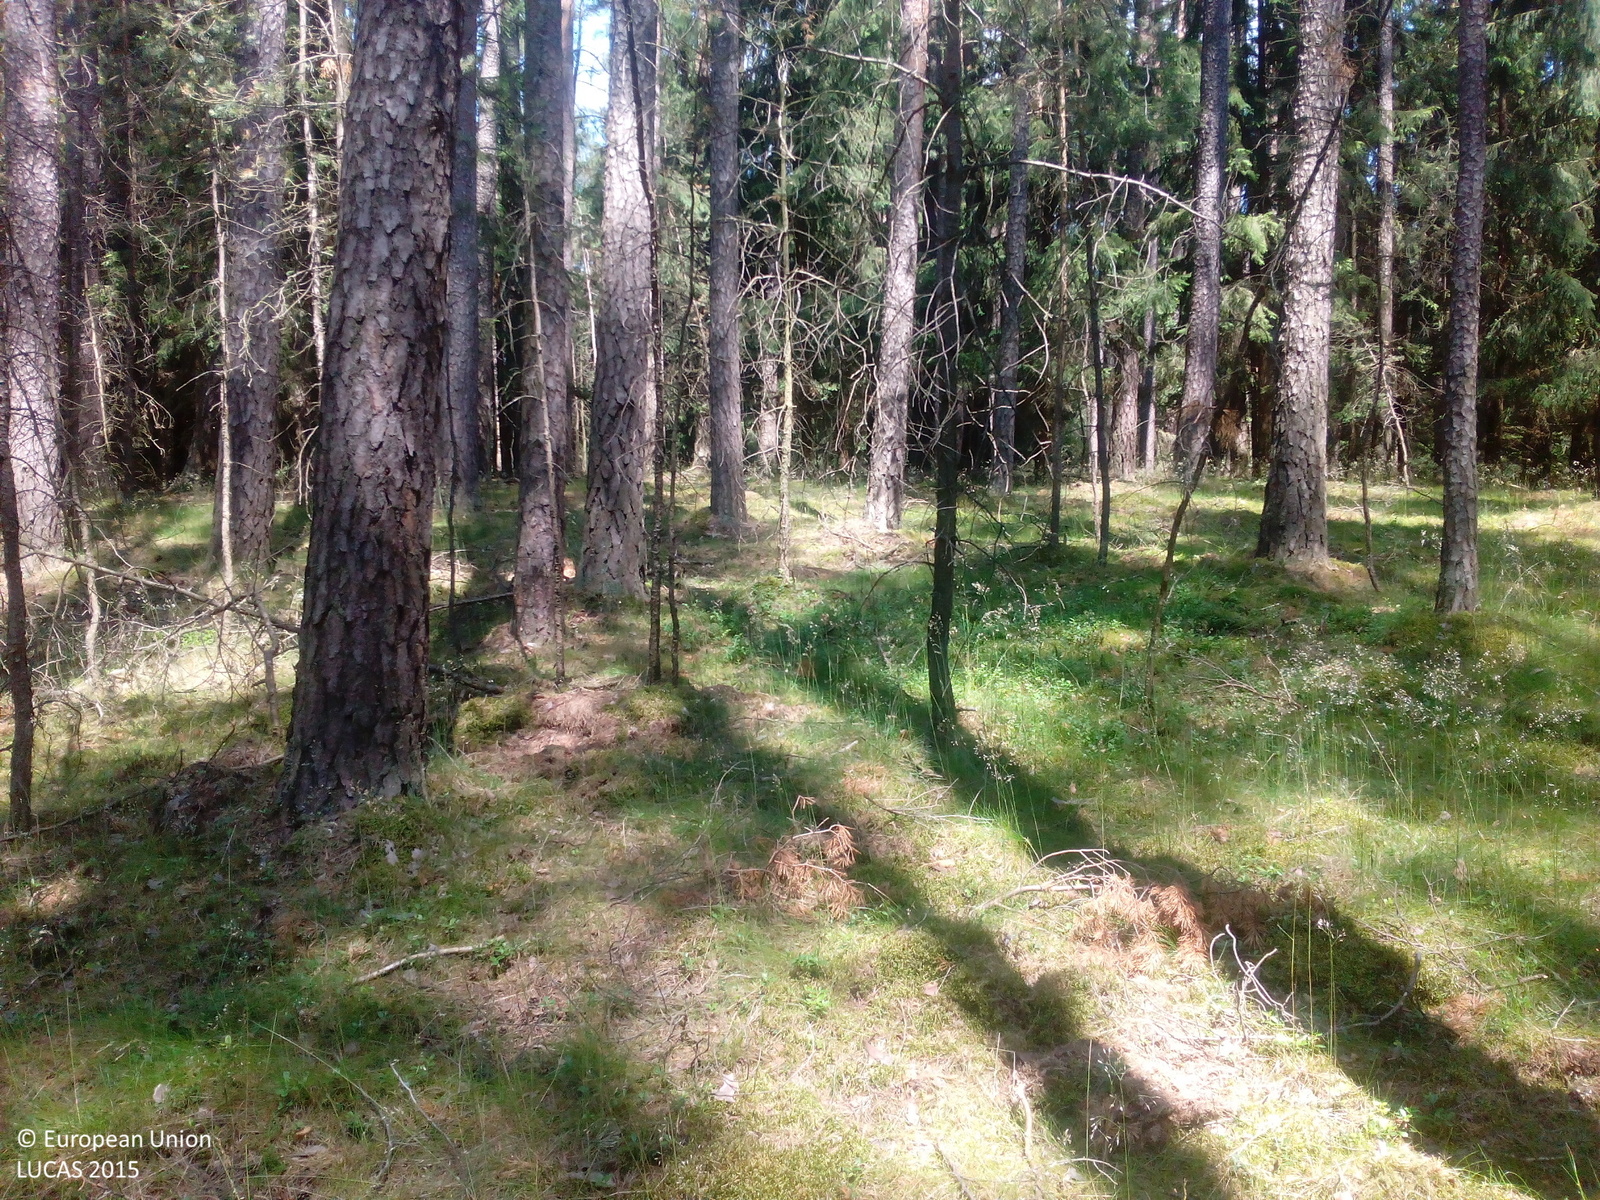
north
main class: Woodland
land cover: Pine dominated coniferous woodland
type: hemiboreal forest and nemoral coniferous forest and mixed broadleaved-coniferous forest
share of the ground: 25 - 50 %
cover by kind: coniferous forest trees 45 %, herbaceous plants 25 %, lichens and mosses 25 %, unconsolidated bare surface 5 %
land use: Forestry
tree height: > 5 m
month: June
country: DE
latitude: 50.0943
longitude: 12.0265
